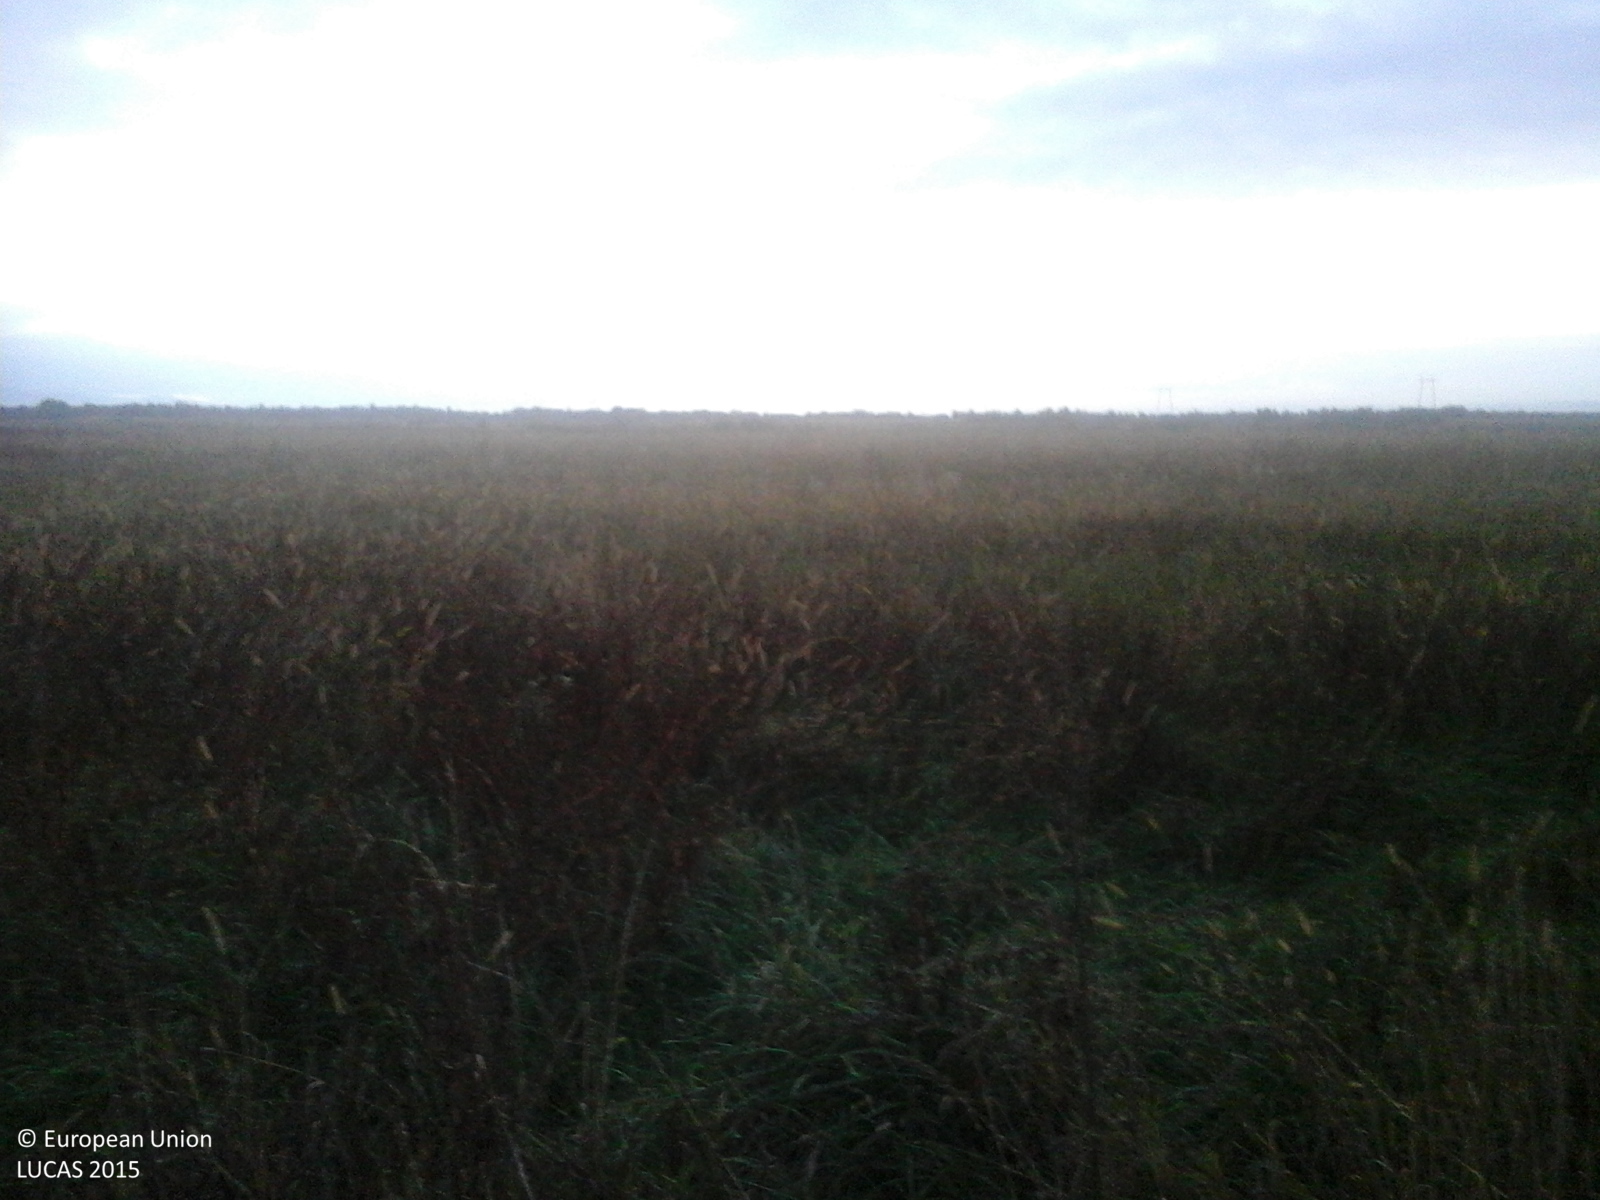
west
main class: Grassland
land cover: Grassland without tree/shrub cover
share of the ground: > 75 %
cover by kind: herbaceous plants 100 %
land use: Agriculture (excluding fallow land and kitchen gardens)
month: October
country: RO
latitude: 45.7352
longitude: 24.8022
